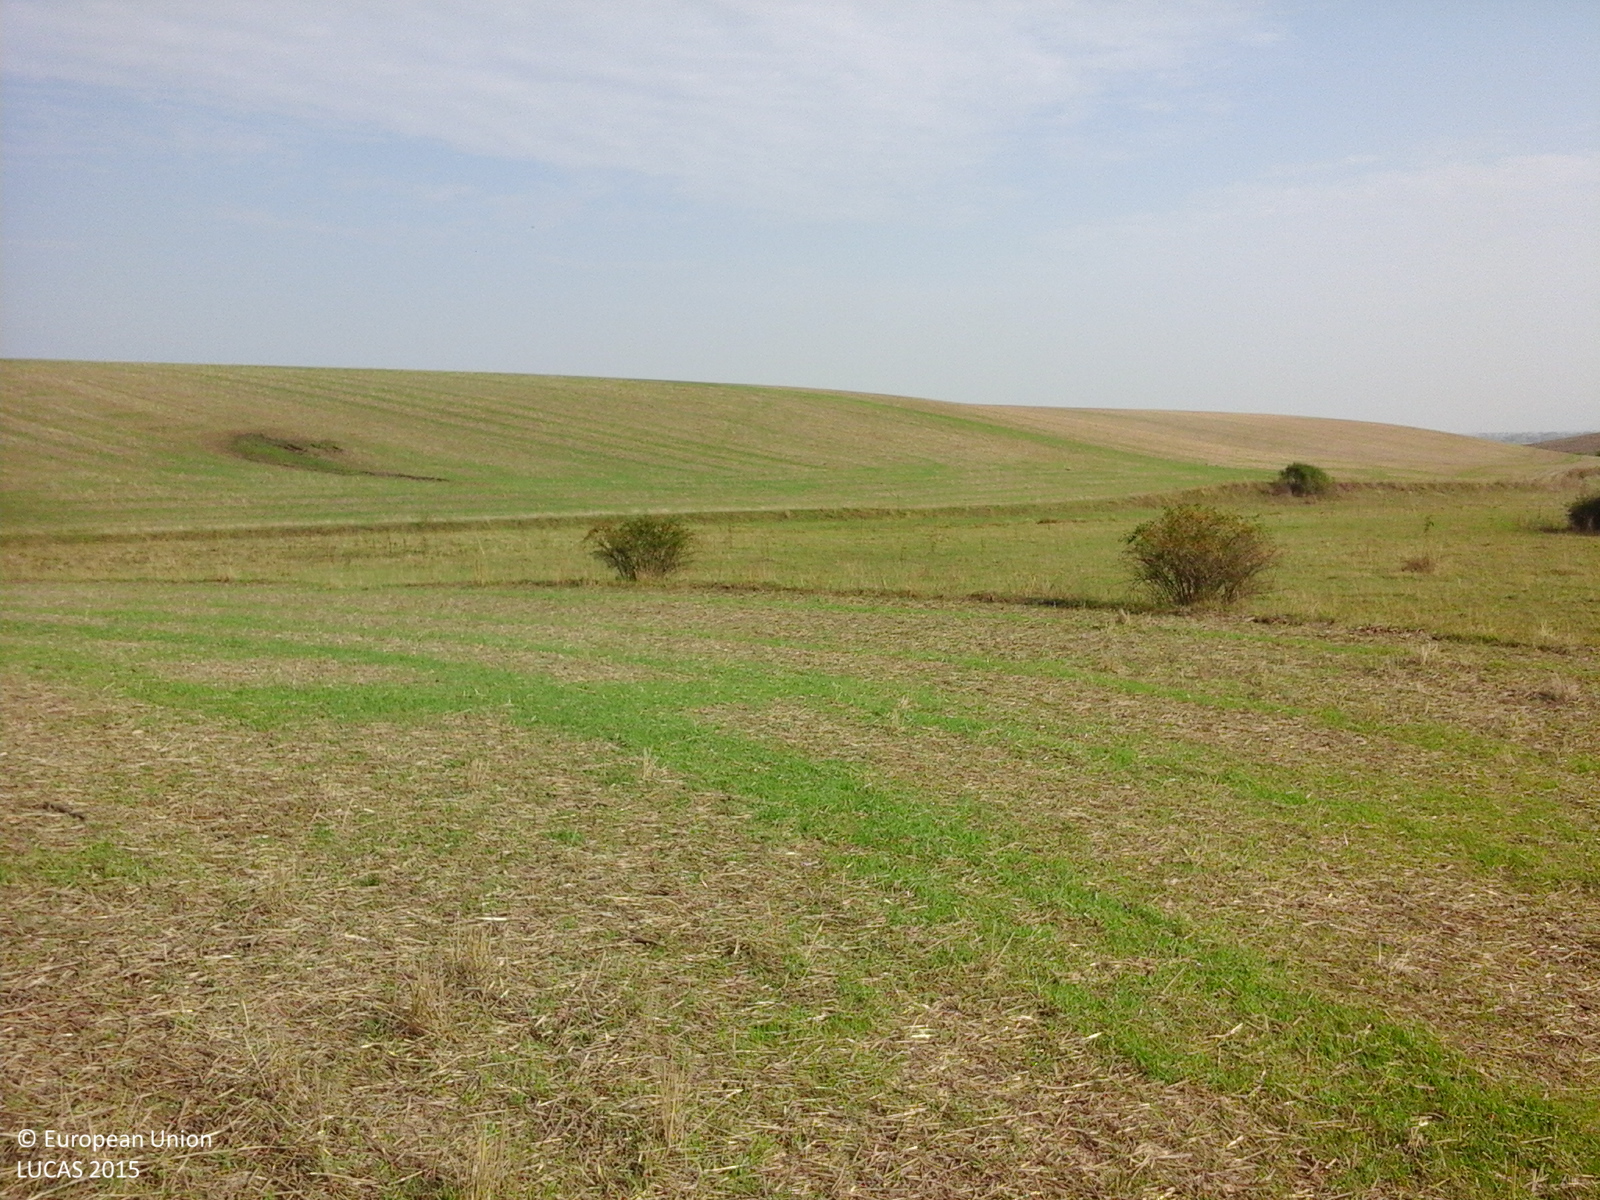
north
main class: Cropland
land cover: Common wheat
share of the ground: 50 - 75 %
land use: Agriculture (excluding fallow land and kitchen gardens)
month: August
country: RO
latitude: 46.0916
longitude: 21.5080
